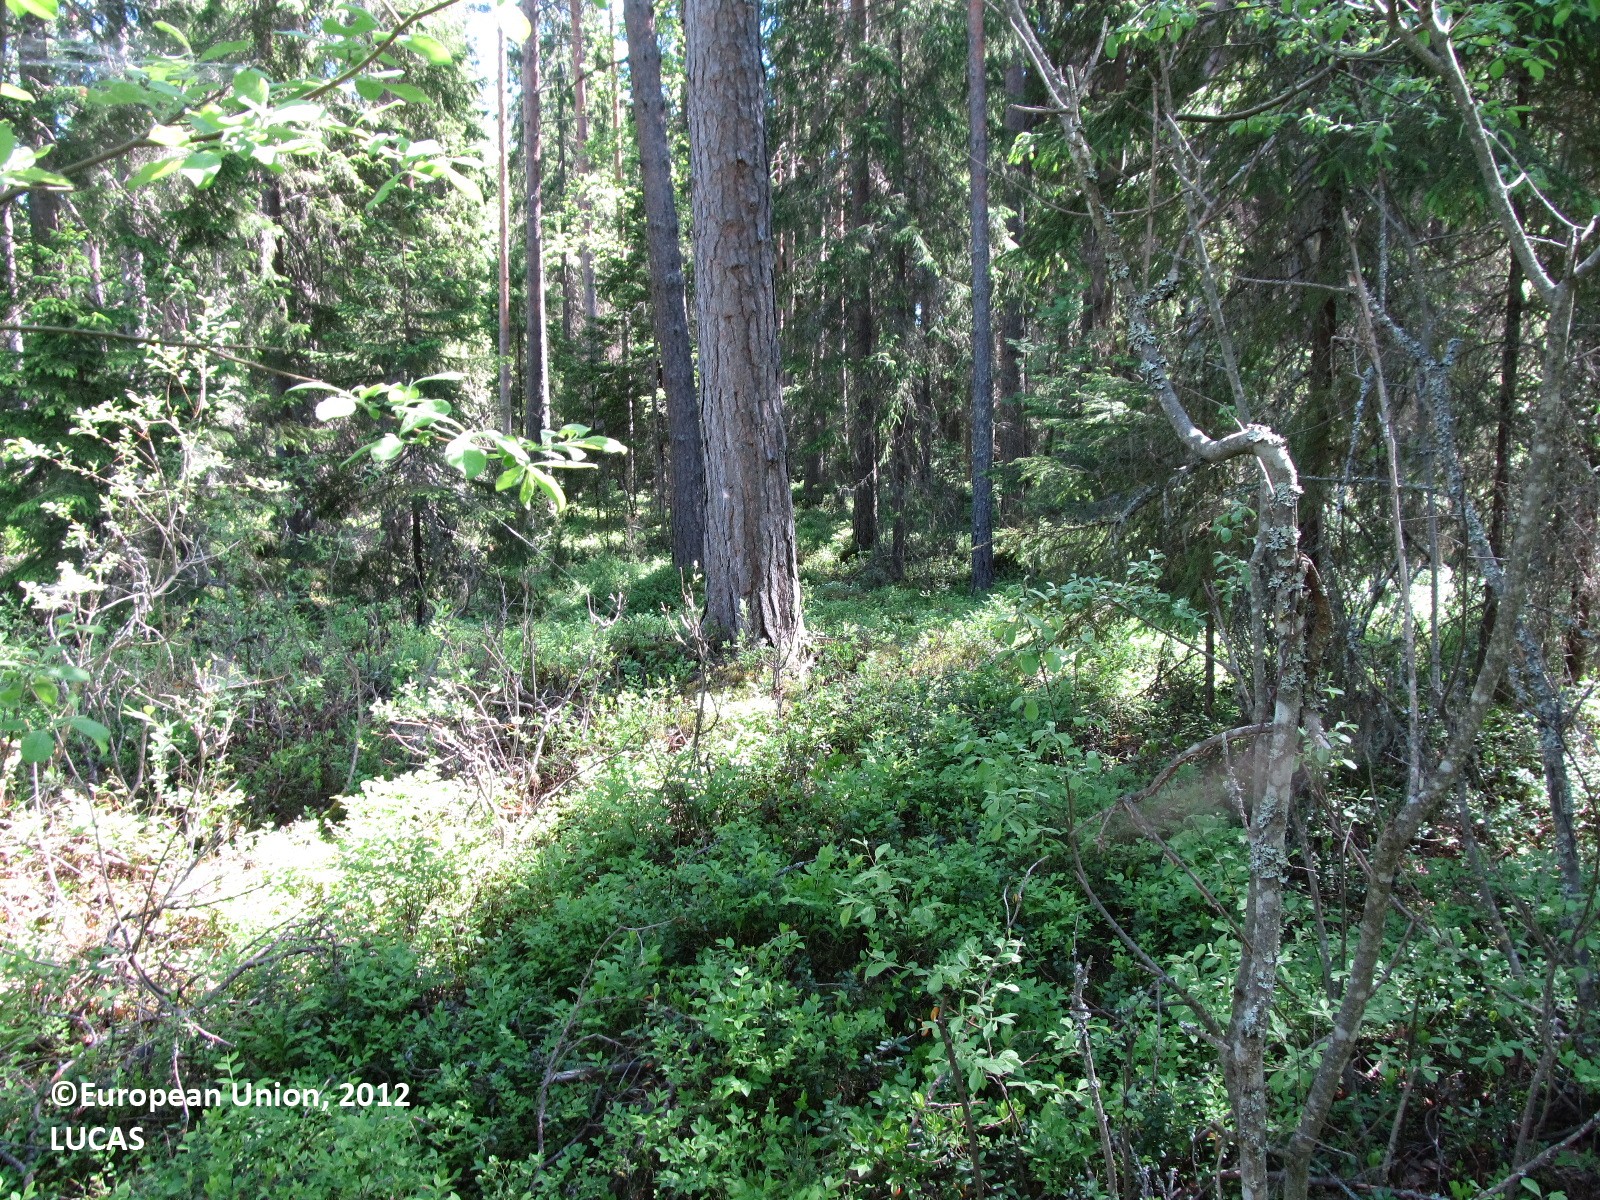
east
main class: Woodland
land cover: Other coniferous woodland
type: boreal forest
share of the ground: 25 - 50 %
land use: Forestry
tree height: > 5 m
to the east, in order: Other coniferous woodland; Pine dominated mixed woodland; Grassland with sparse tree/shrub cover; Pine dominated mixed woodland; Tracks; Pine dominated mixed woodland; Spruce dominated mixed woodland; Spruce dominated coniferous woodland; Ditches and canals; Barley; Ditches and canals; Grass margins; Paved roads, cycling and walking lanes; Grass margins; Other bare soil; Grassland with sparse tree/shrub cover; Rocks and stones; Grassland with sparse tree/shrub cover
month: June
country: FI
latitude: 62.9925
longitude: 27.7571
